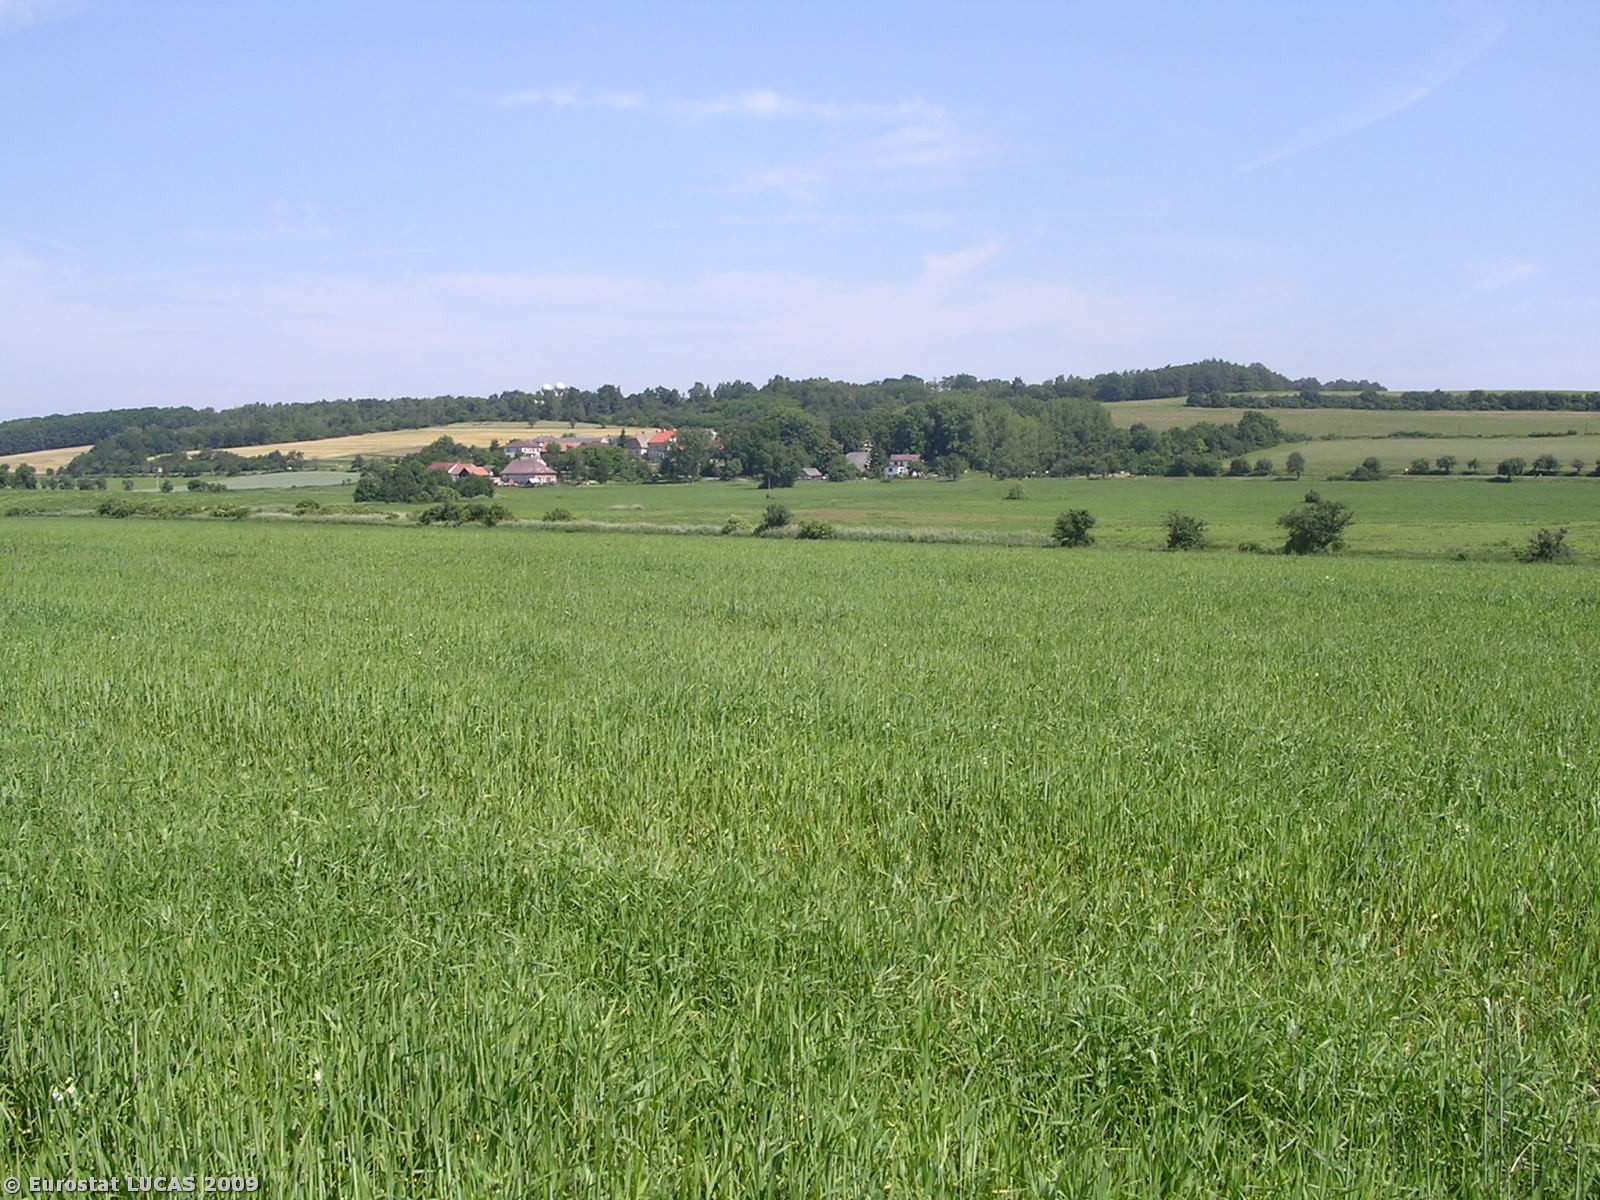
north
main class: Cropland
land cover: Barley
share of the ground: > 75 %
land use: Agriculture (excluding fallow land and kitchen gardens)
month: June
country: CZ
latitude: 50.4683
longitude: 15.0609
